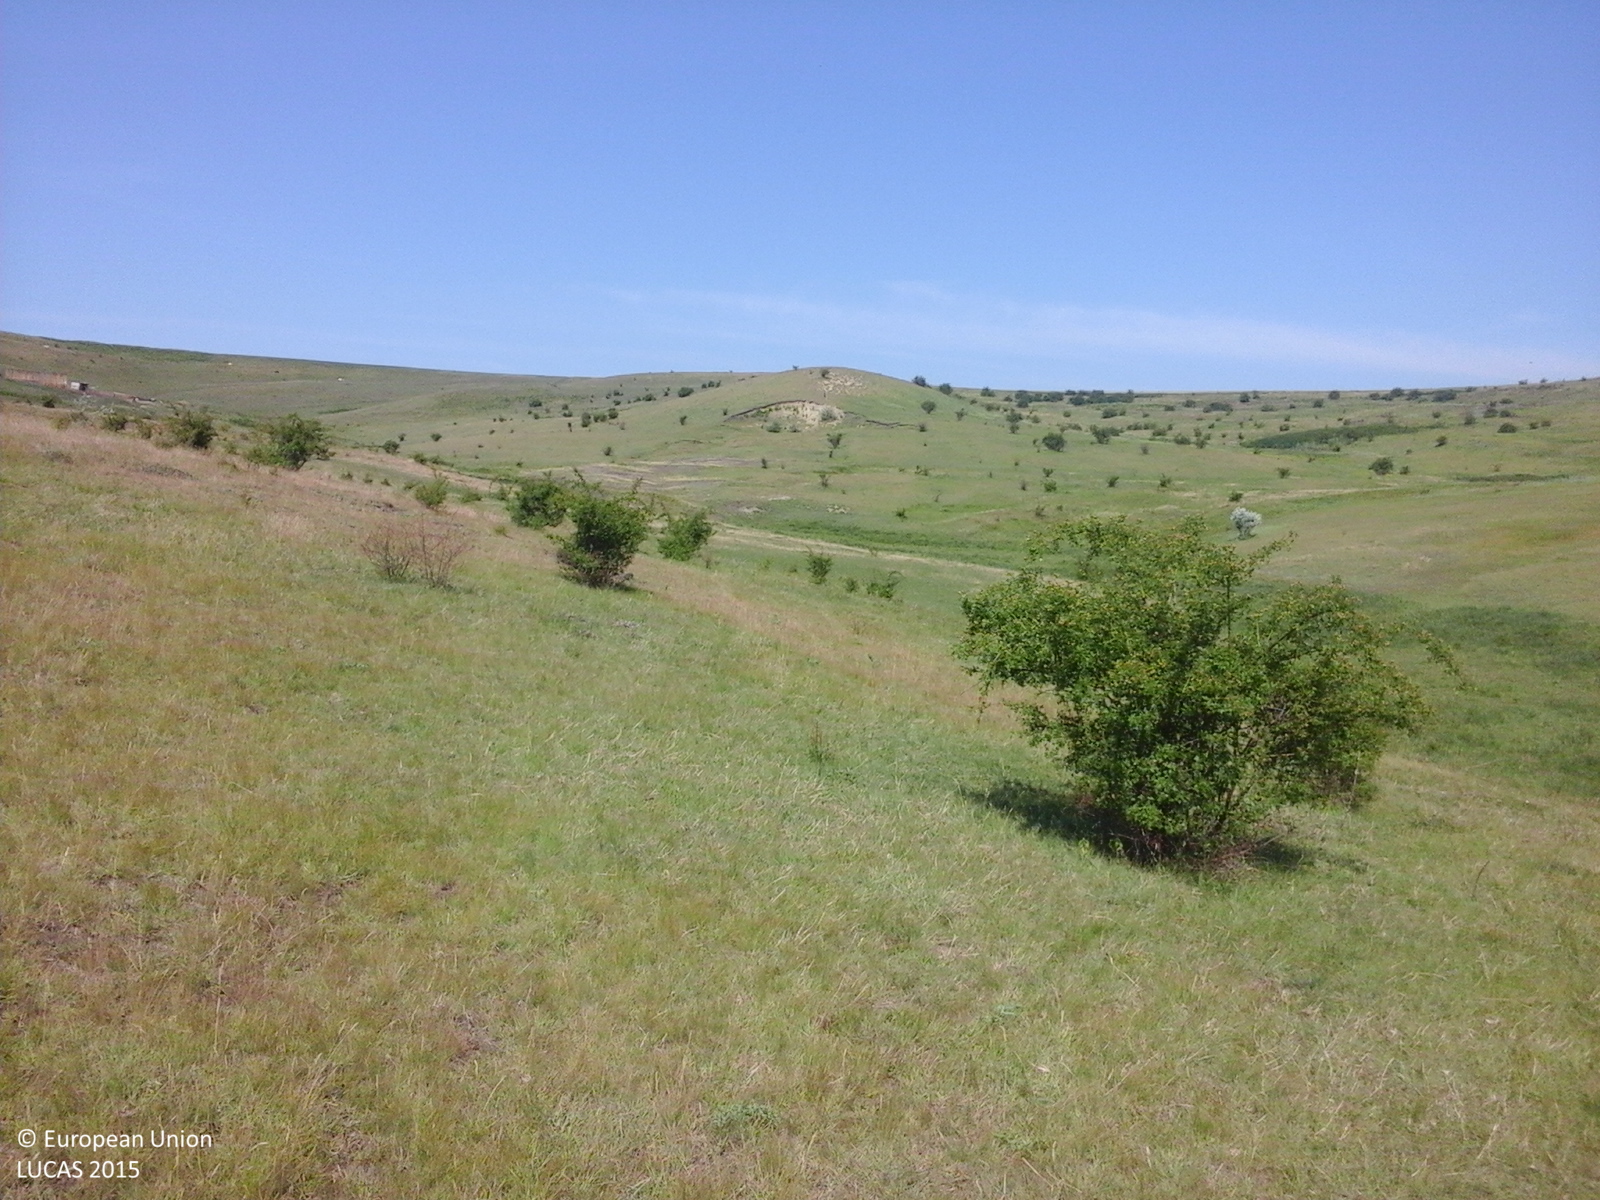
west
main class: Grassland
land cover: Grassland with sparse tree/shrub cover
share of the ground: > 75 %
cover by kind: herbaceous plants 85 %, shrubs 10 %, broadleaved forest trees 5 %
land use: Agriculture (excluding fallow land and kitchen gardens)
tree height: < 5 m
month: June
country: RO
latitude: 47.6854
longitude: 27.2026
